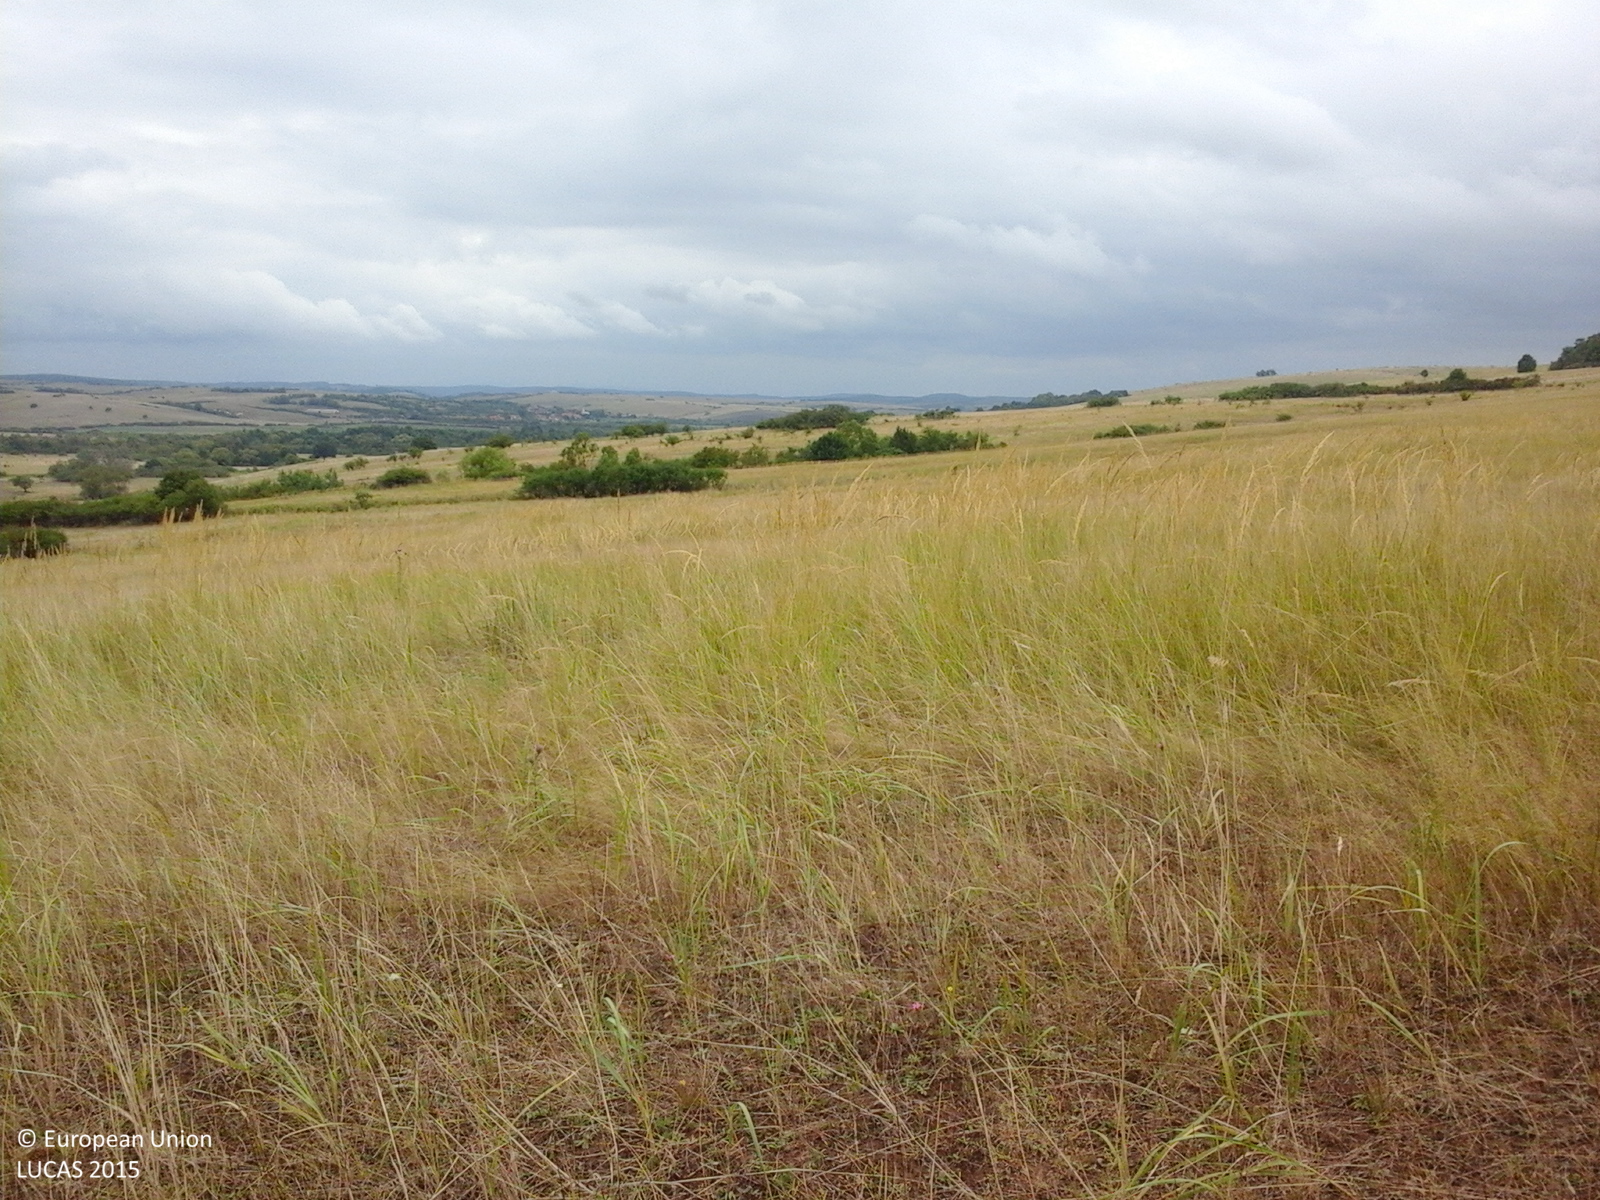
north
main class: Grassland
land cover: Grassland without tree/shrub cover
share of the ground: > 75 %
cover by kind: herbaceous plants 100 %
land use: Agriculture (excluding fallow land and kitchen gardens)
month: August
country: RO
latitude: 45.8567
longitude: 21.8228
